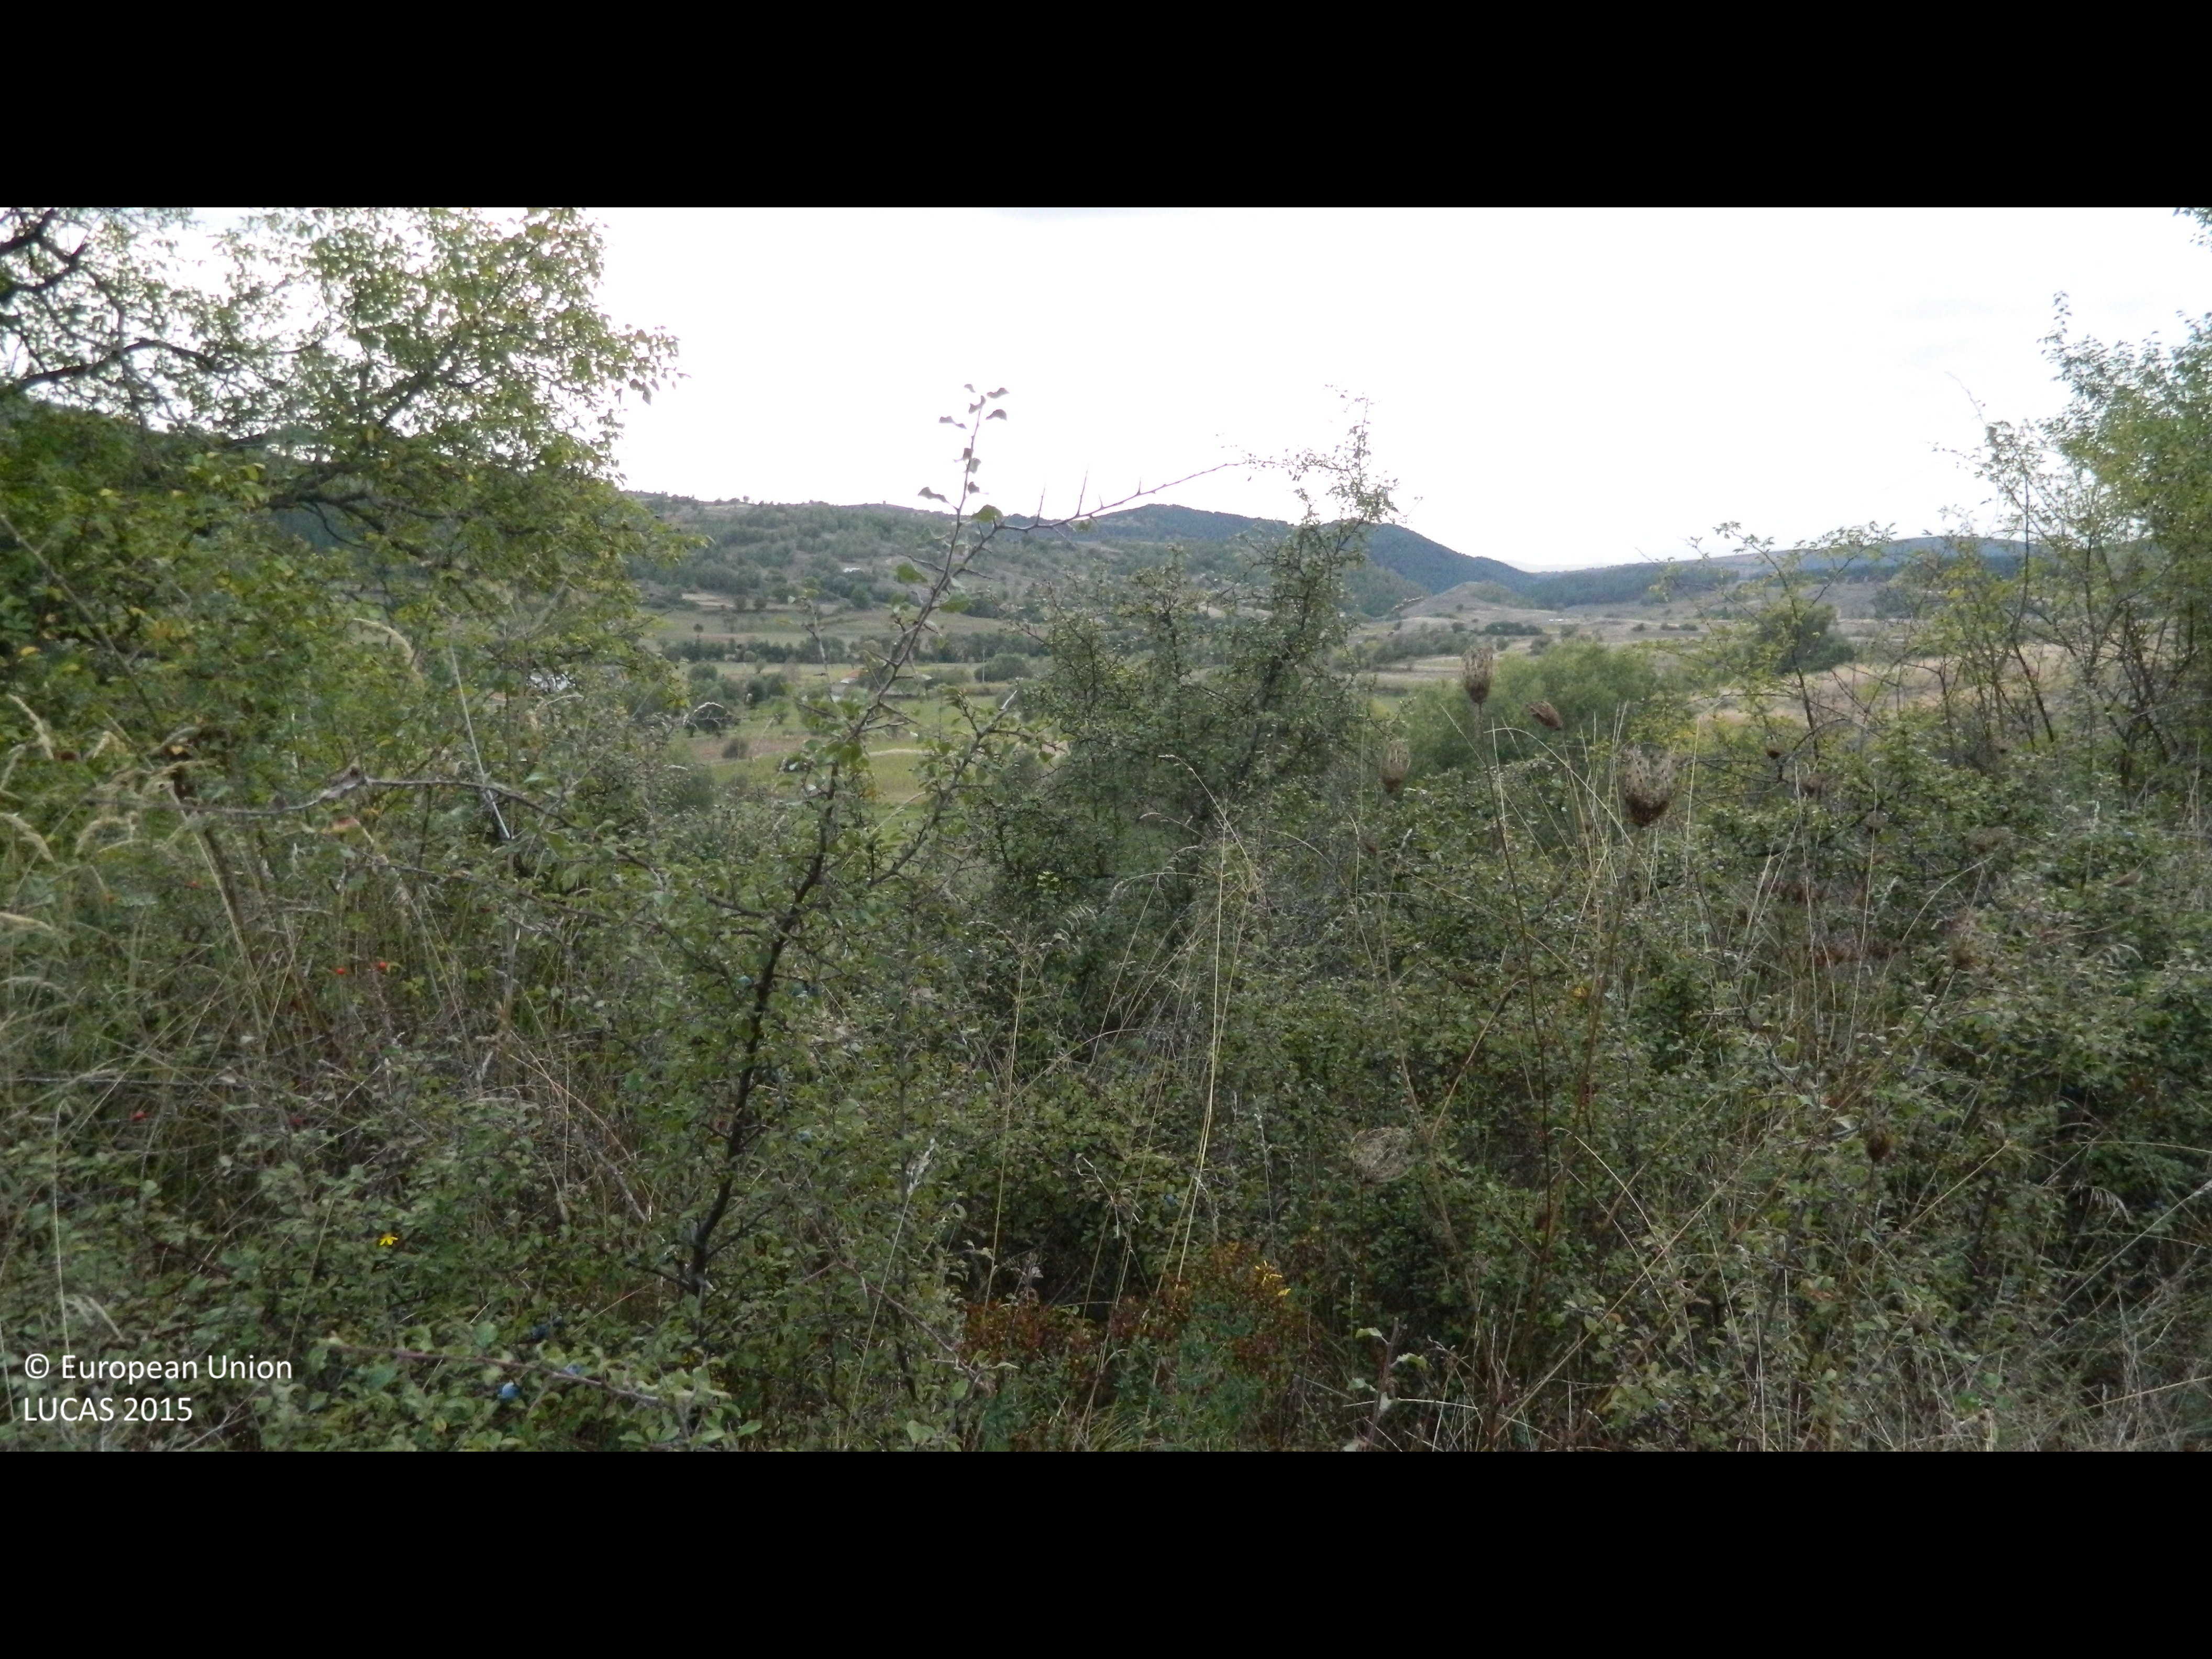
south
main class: Shrubland
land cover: Shrubland with sparse tree cover
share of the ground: > 75 %
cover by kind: shrubs 75 %, herbaceous plants 20 %, broadleaved forest trees 5 %
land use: Abandoned areas
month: September
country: BG
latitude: 41.5948
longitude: 24.0579
